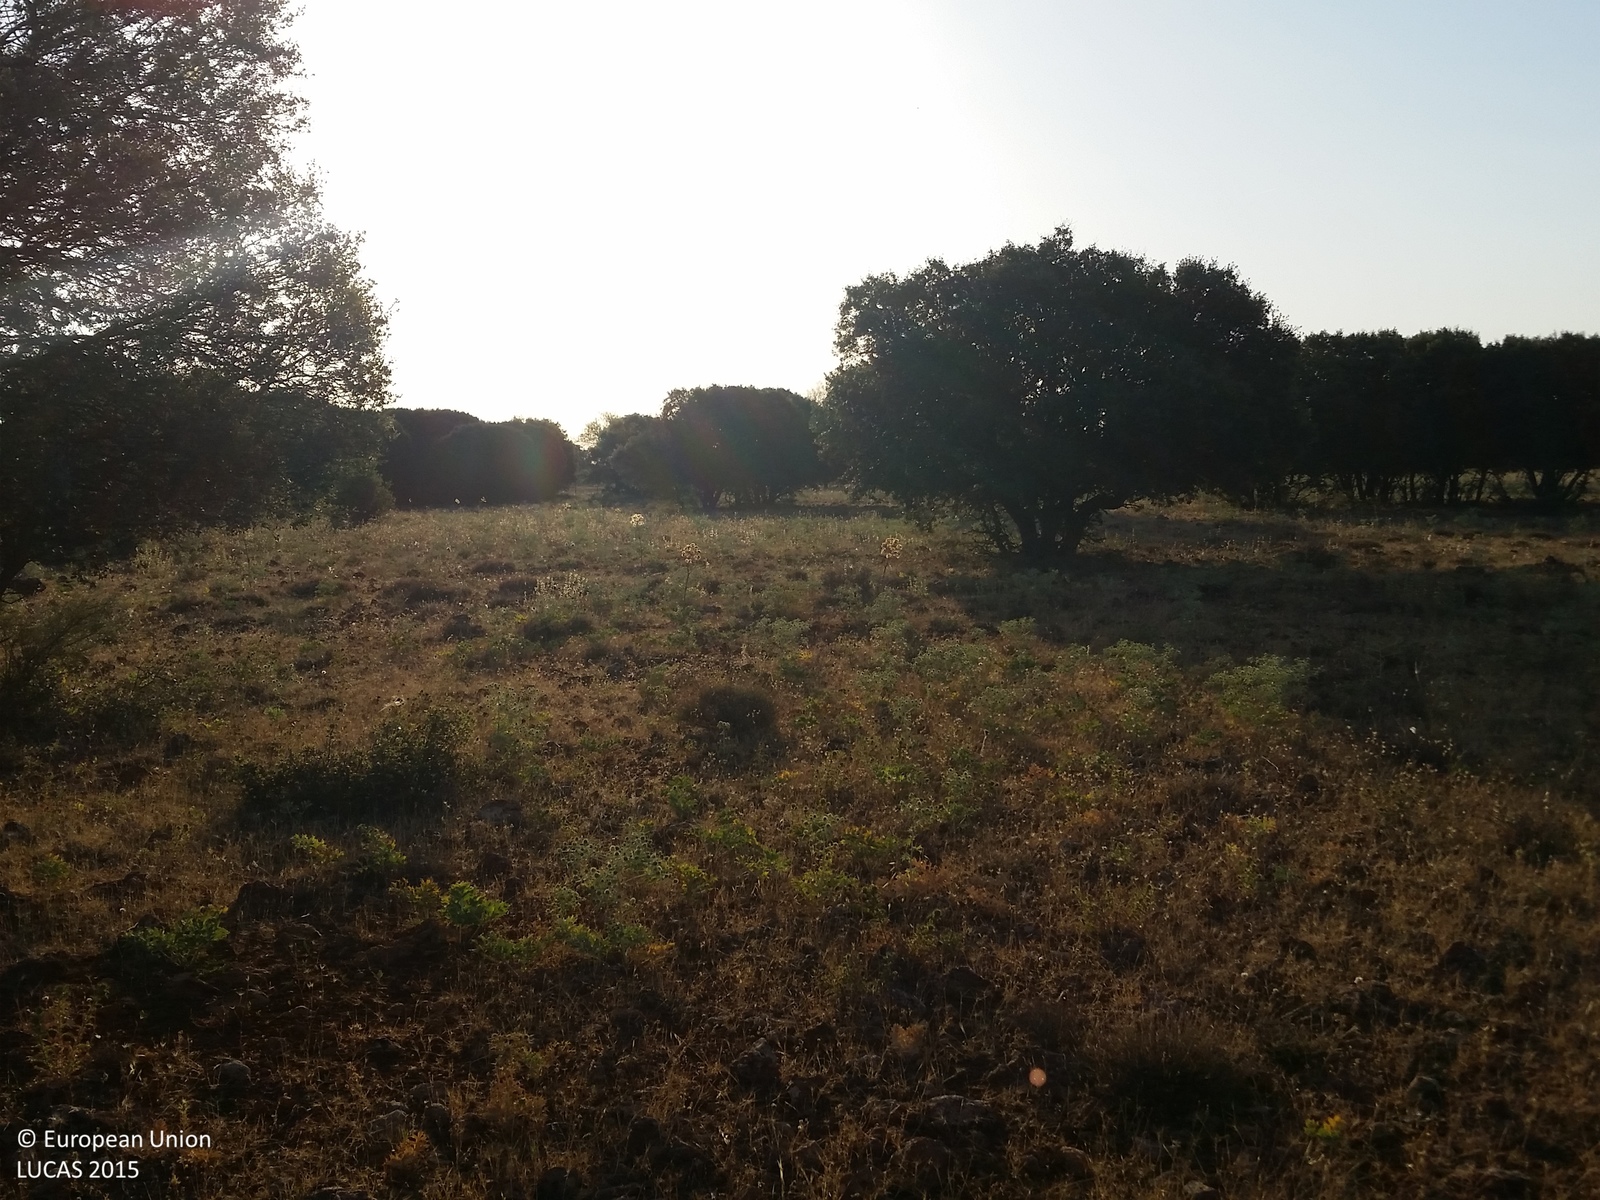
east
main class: Woodland
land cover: Broadleaved woodland
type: broadleaved evergreen forest
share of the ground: 50 - 75 %
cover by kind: broadleaved forest trees 50 %, shrubs 25 %, consolidated bare surface 15 %, herbaceous plants 10 %
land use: Semi-natural and natural areas not in use
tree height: < 5 m
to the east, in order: Broadleaved woodland; Grassland without tree/shrub cover; Broadleaved woodland
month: June
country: ES
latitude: 38.7318
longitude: -2.6456
